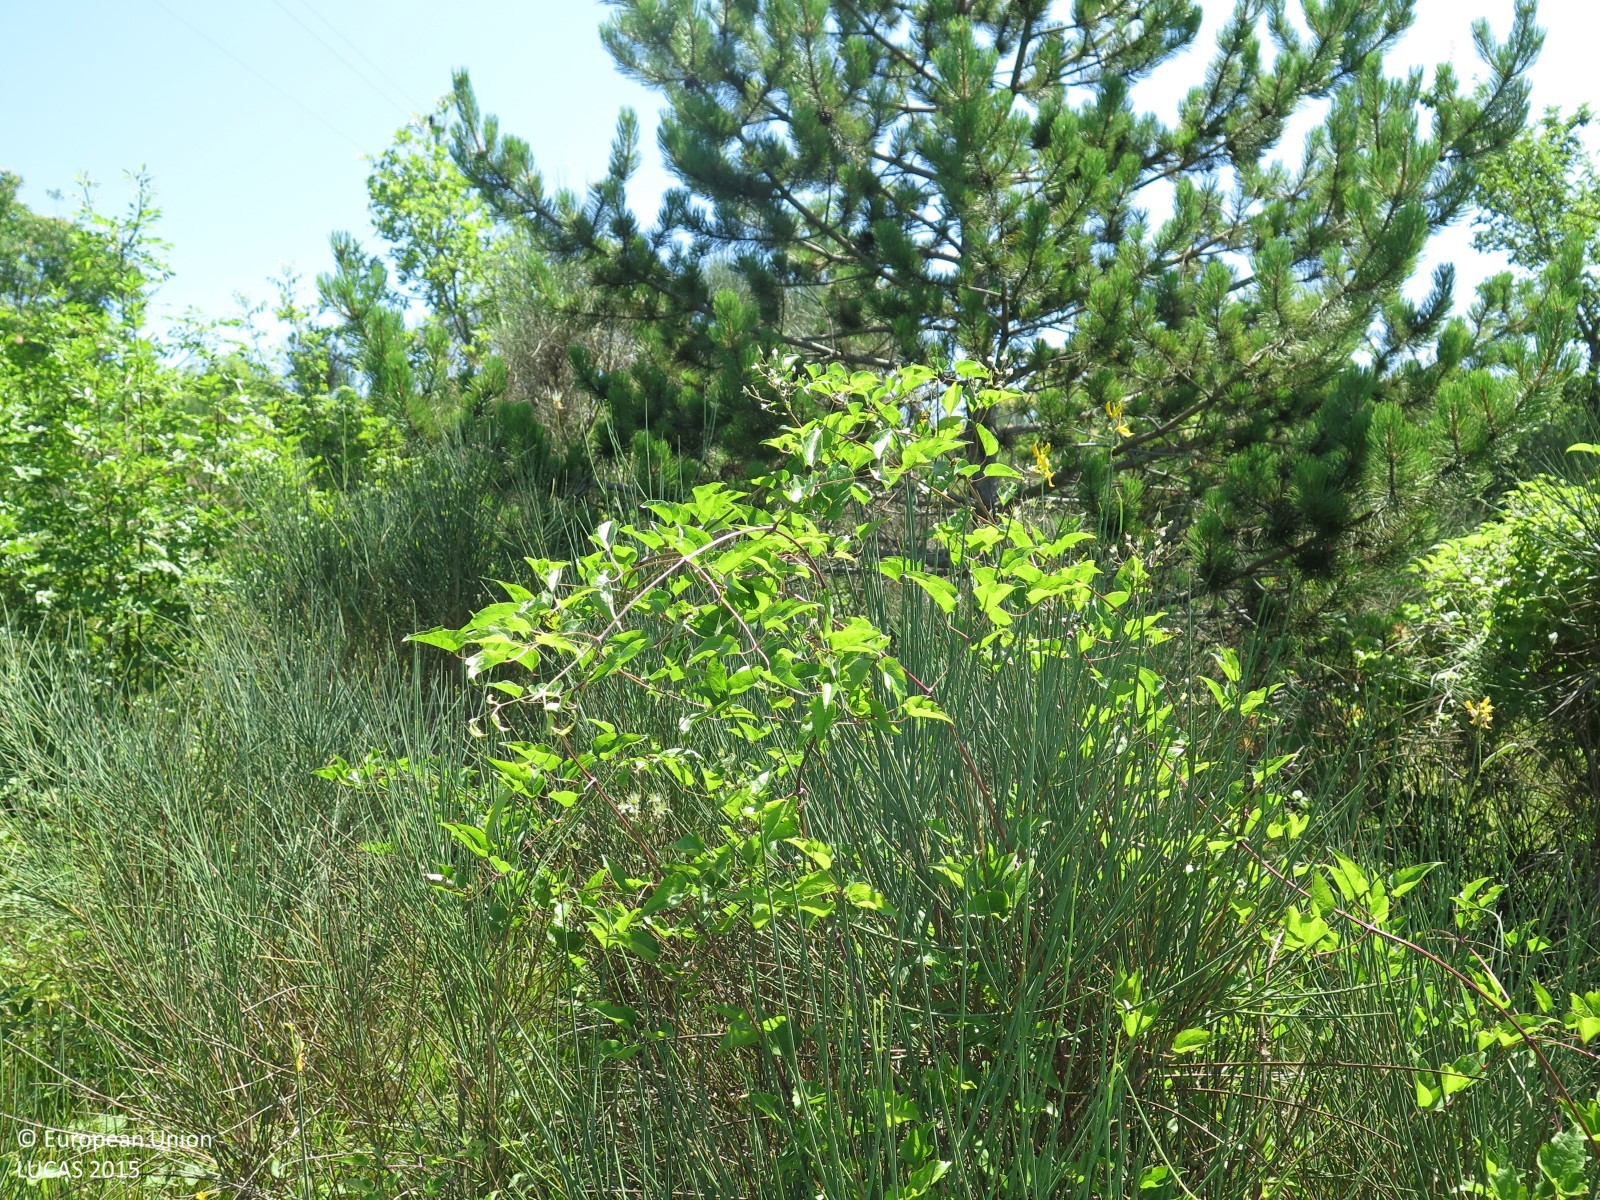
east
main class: Woodland
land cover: Other mixed woodland
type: mesophytic deciduous forest
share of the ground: > 75 %
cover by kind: broadleaved forest trees 65 %, coniferous forest trees 25 %, shrubs 5 %, herbaceous plants 5 %
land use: Semi-natural and natural areas not in use
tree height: < 5 m
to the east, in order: Other mixed woodland; Electric lines; Other mixed woodland; Grassland with sparse tree/shrub cover; Tracks; Grass margins; Vineyards; Shrubland with sparse tree cover; Grassland with sparse tree/shrub cover; Paved roads, cycling and walking lanes; Grass margins; Shrubland with sparse tree cover; Abandoned hedges
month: July
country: HR
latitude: 45.3671
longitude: 13.7105
